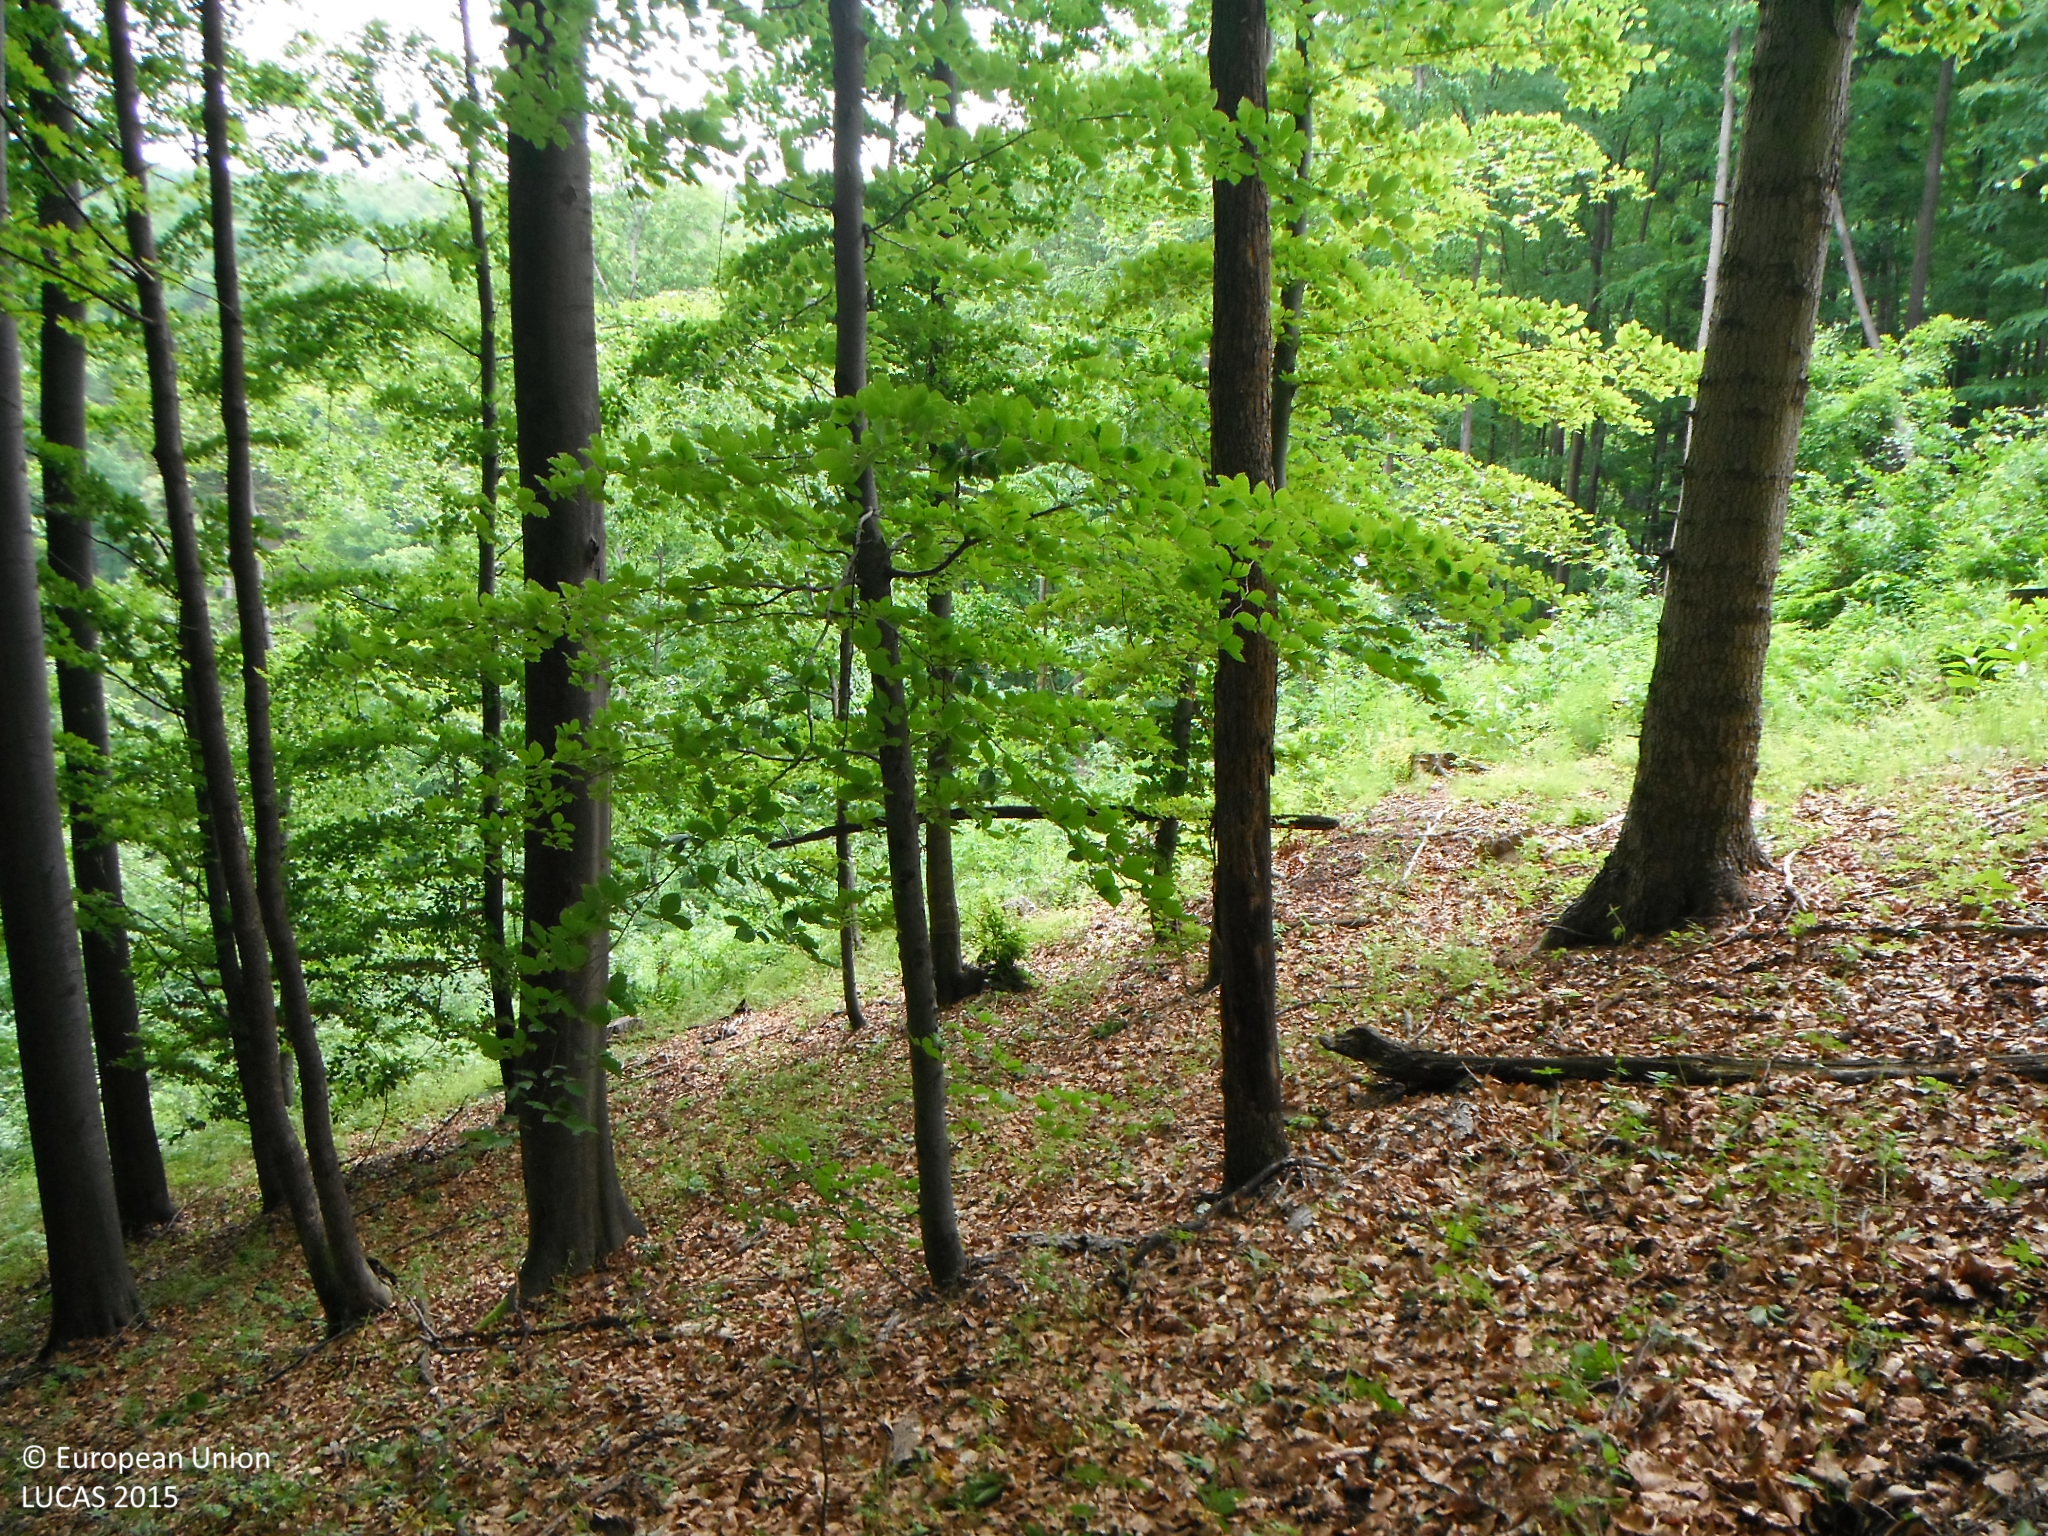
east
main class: Woodland
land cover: Other mixed woodland
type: mountainous beech forest
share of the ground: > 75 %
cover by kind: broadleaved forest trees 75 %, coniferous forest trees 25 %
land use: Forestry
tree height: > 5 m
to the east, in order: Other mixed woodland; Spontaneously vegetated surfaces; Other mixed woodland; Broadleaved woodland; Rivers and streams; Grass margins; Tracks; Broadleaved woodland; Other mixed woodland
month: May
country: SK
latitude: 48.4913
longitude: 18.9645
